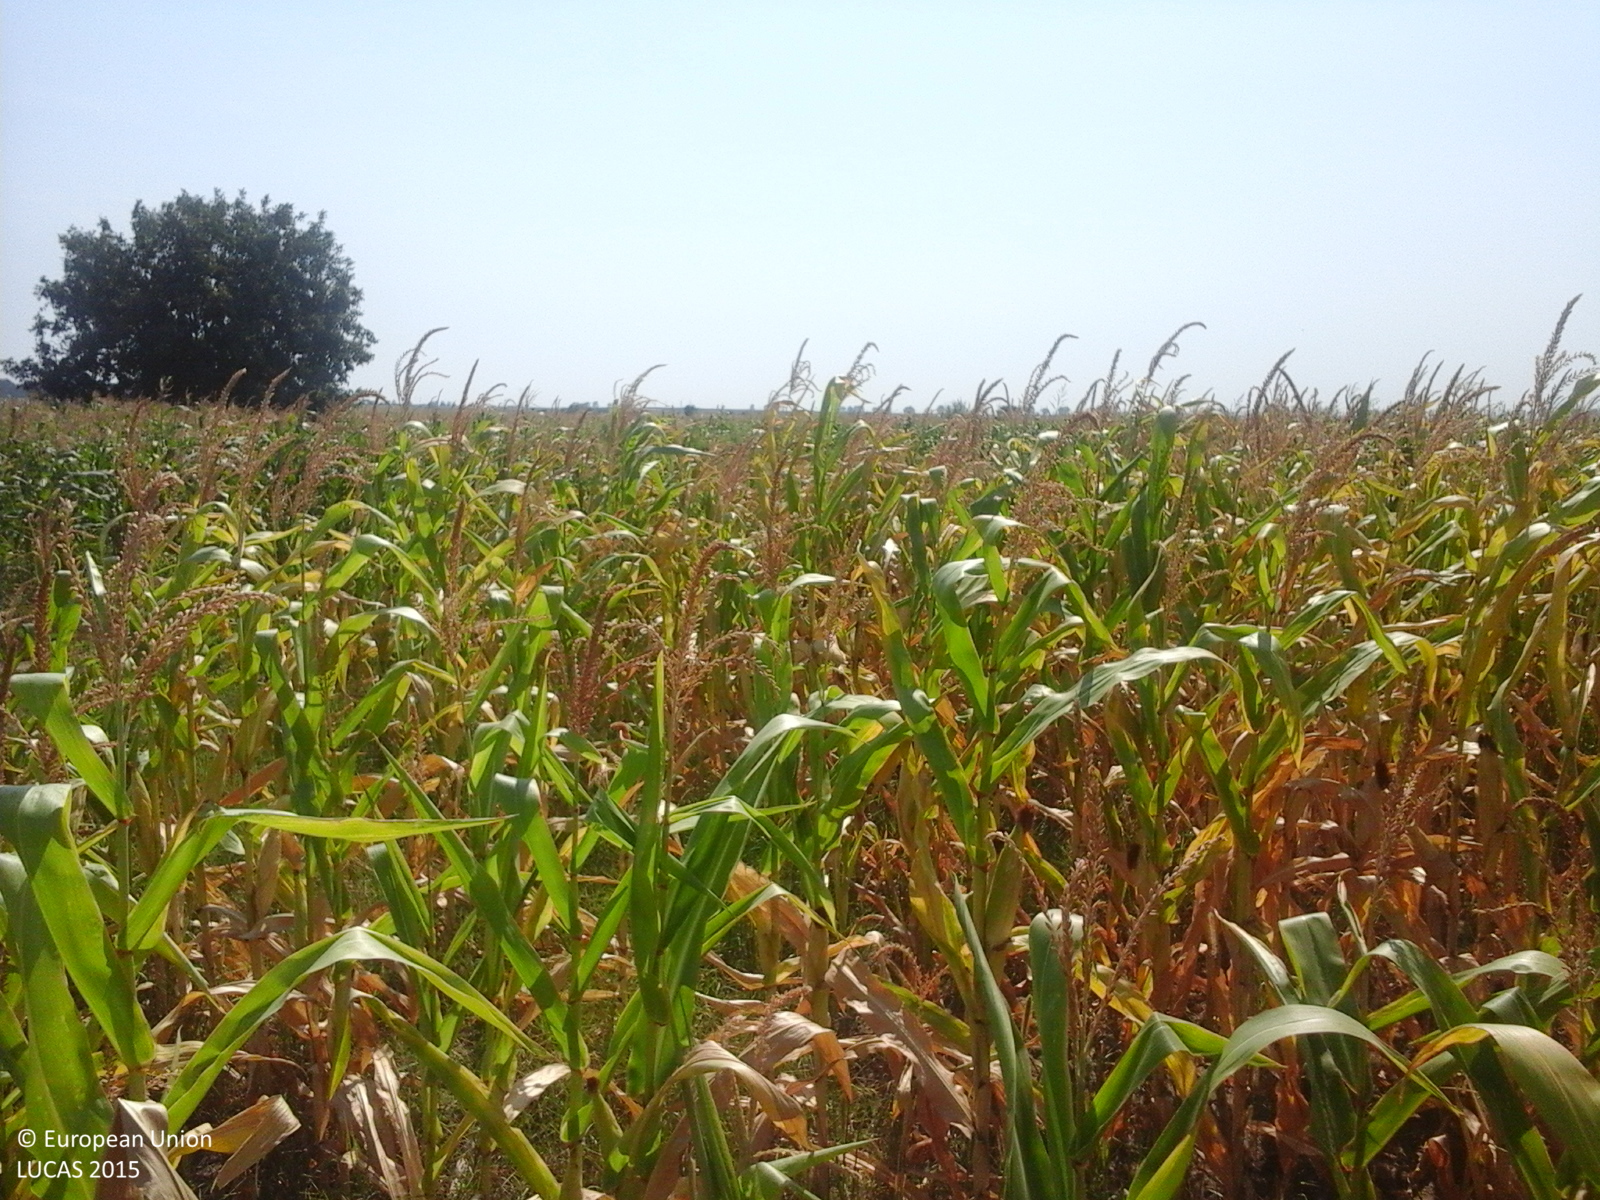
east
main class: Cropland
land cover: Maize
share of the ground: > 75 %
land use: Agriculture (excluding fallow land and kitchen gardens)
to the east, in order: Maize; Tracks; Vineyards; Maize
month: August
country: RO
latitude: 45.7420
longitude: 27.4942
